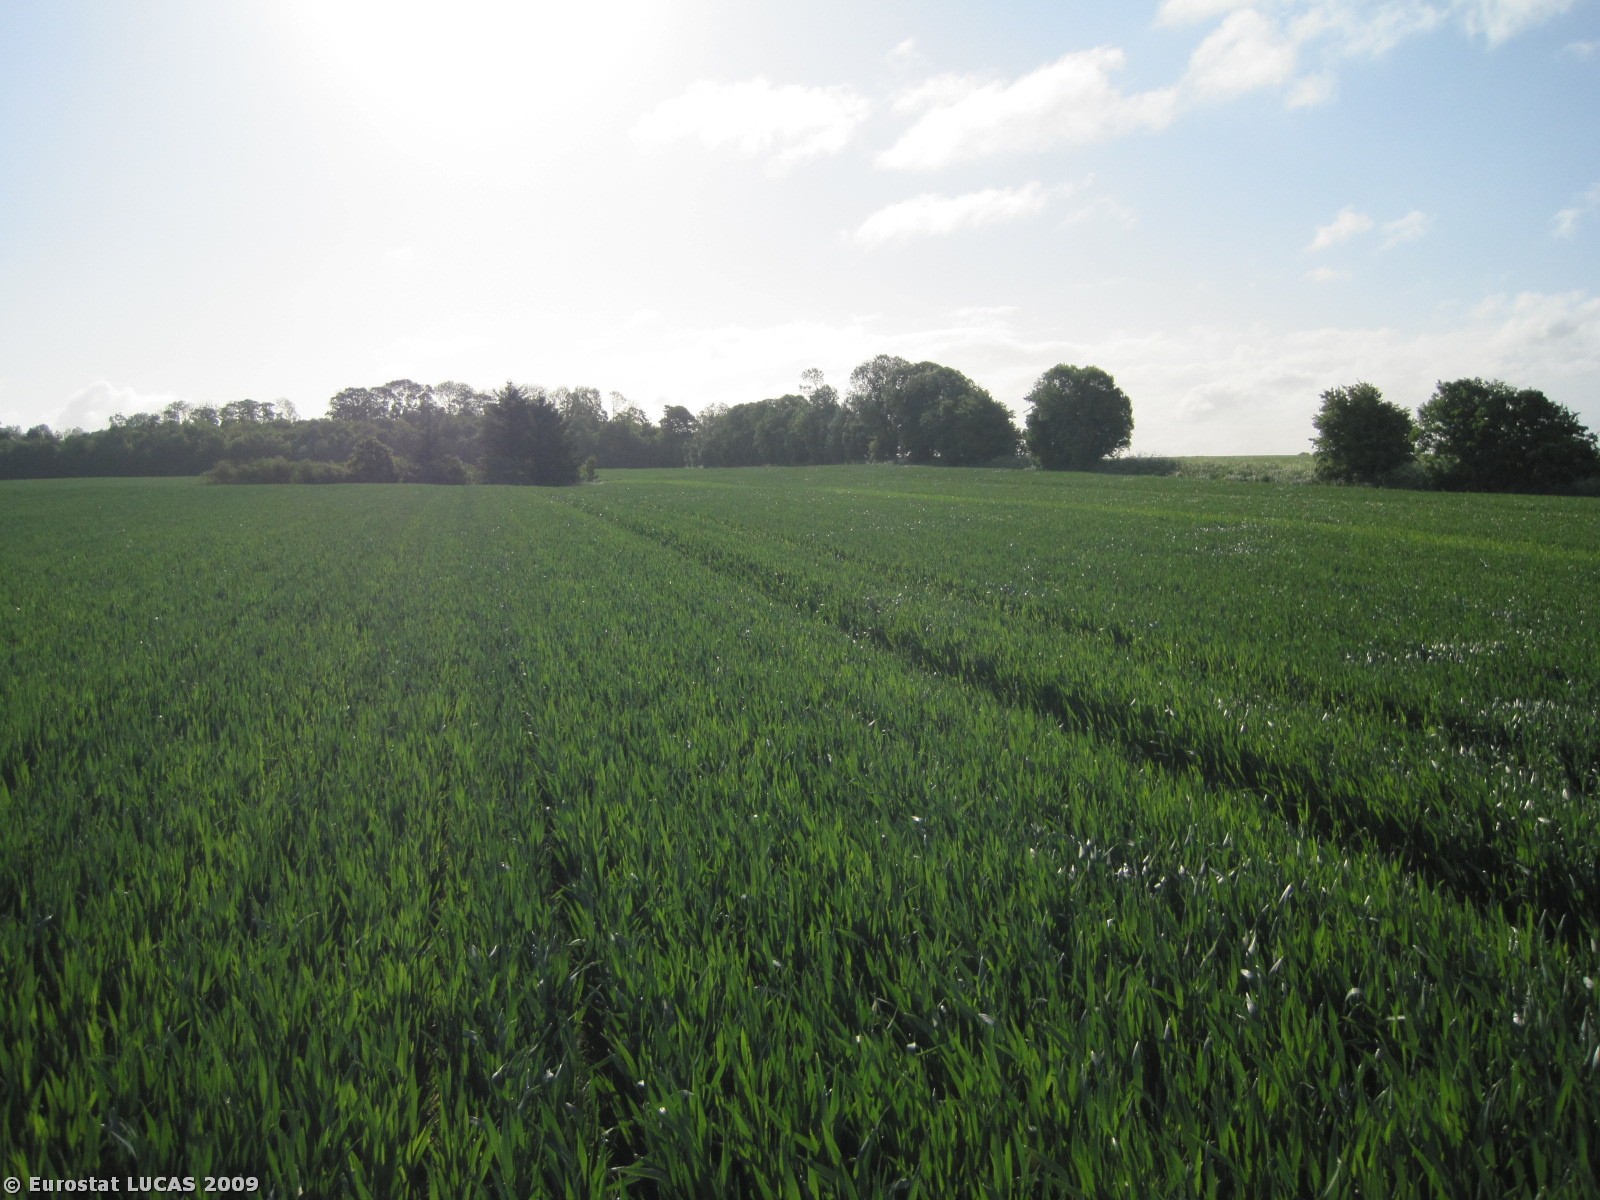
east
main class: Cropland
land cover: Common wheat
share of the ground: > 75 %
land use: Agriculture (excluding fallow land and kitchen gardens)
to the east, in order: Common wheat
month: May
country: DK
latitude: 56.5472
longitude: 10.0812
